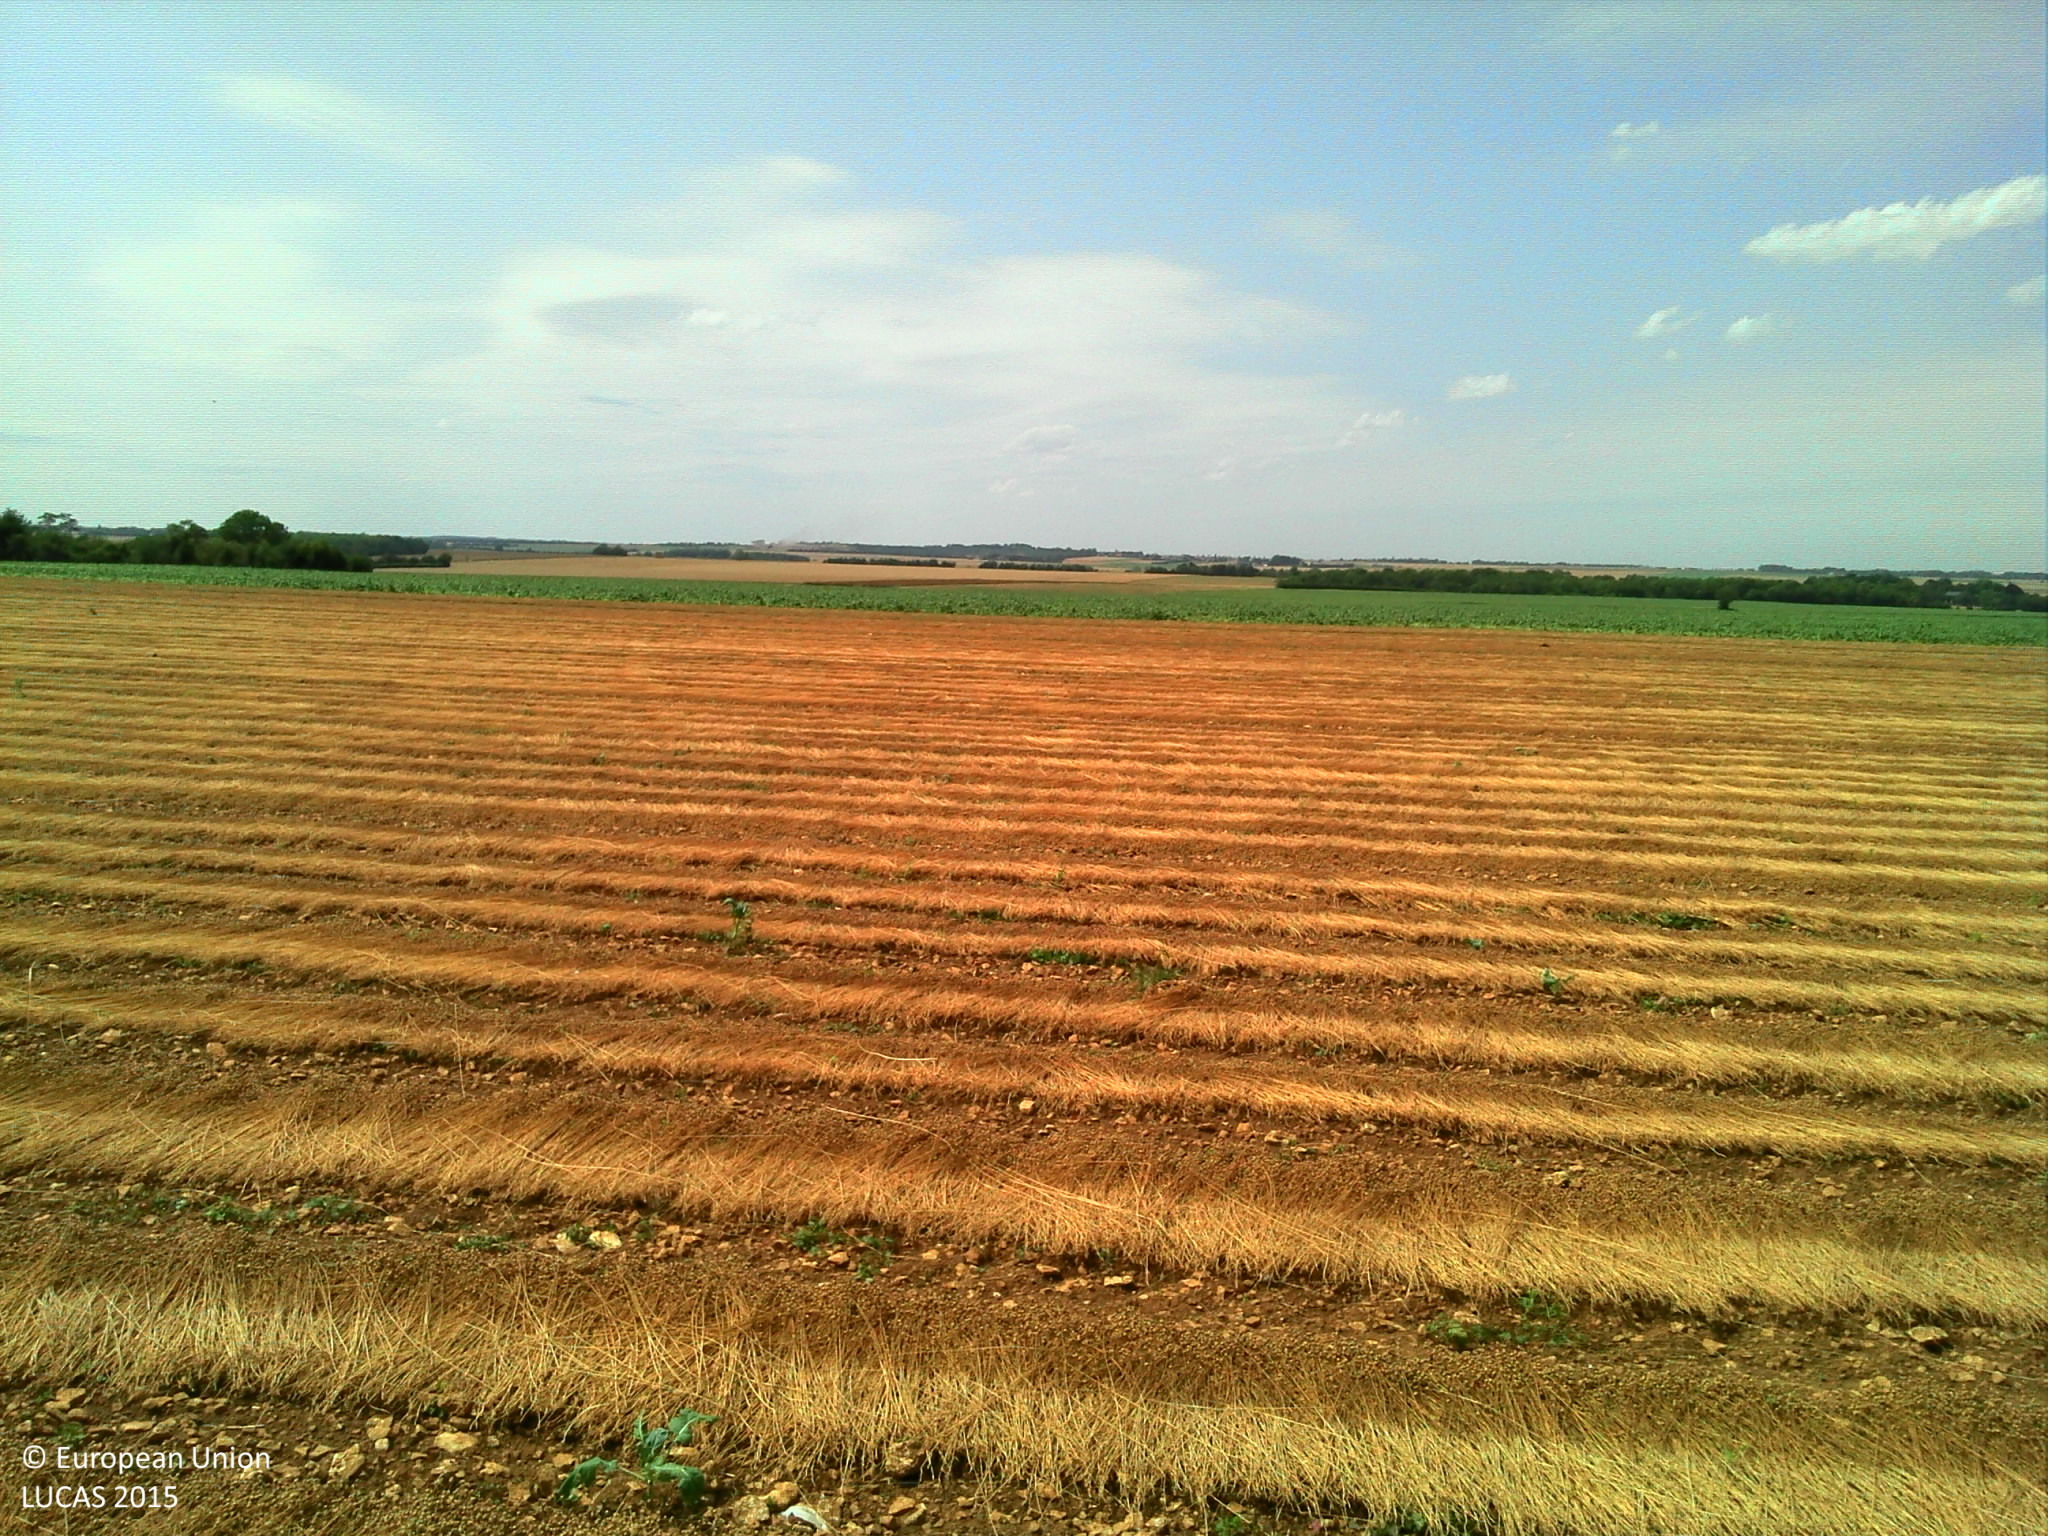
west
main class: Cropland
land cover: Other fibre and oleaginous crops
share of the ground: > 75 %
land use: Agriculture (excluding fallow land and kitchen gardens)
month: July
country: FR
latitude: 49.0370
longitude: -0.1963
